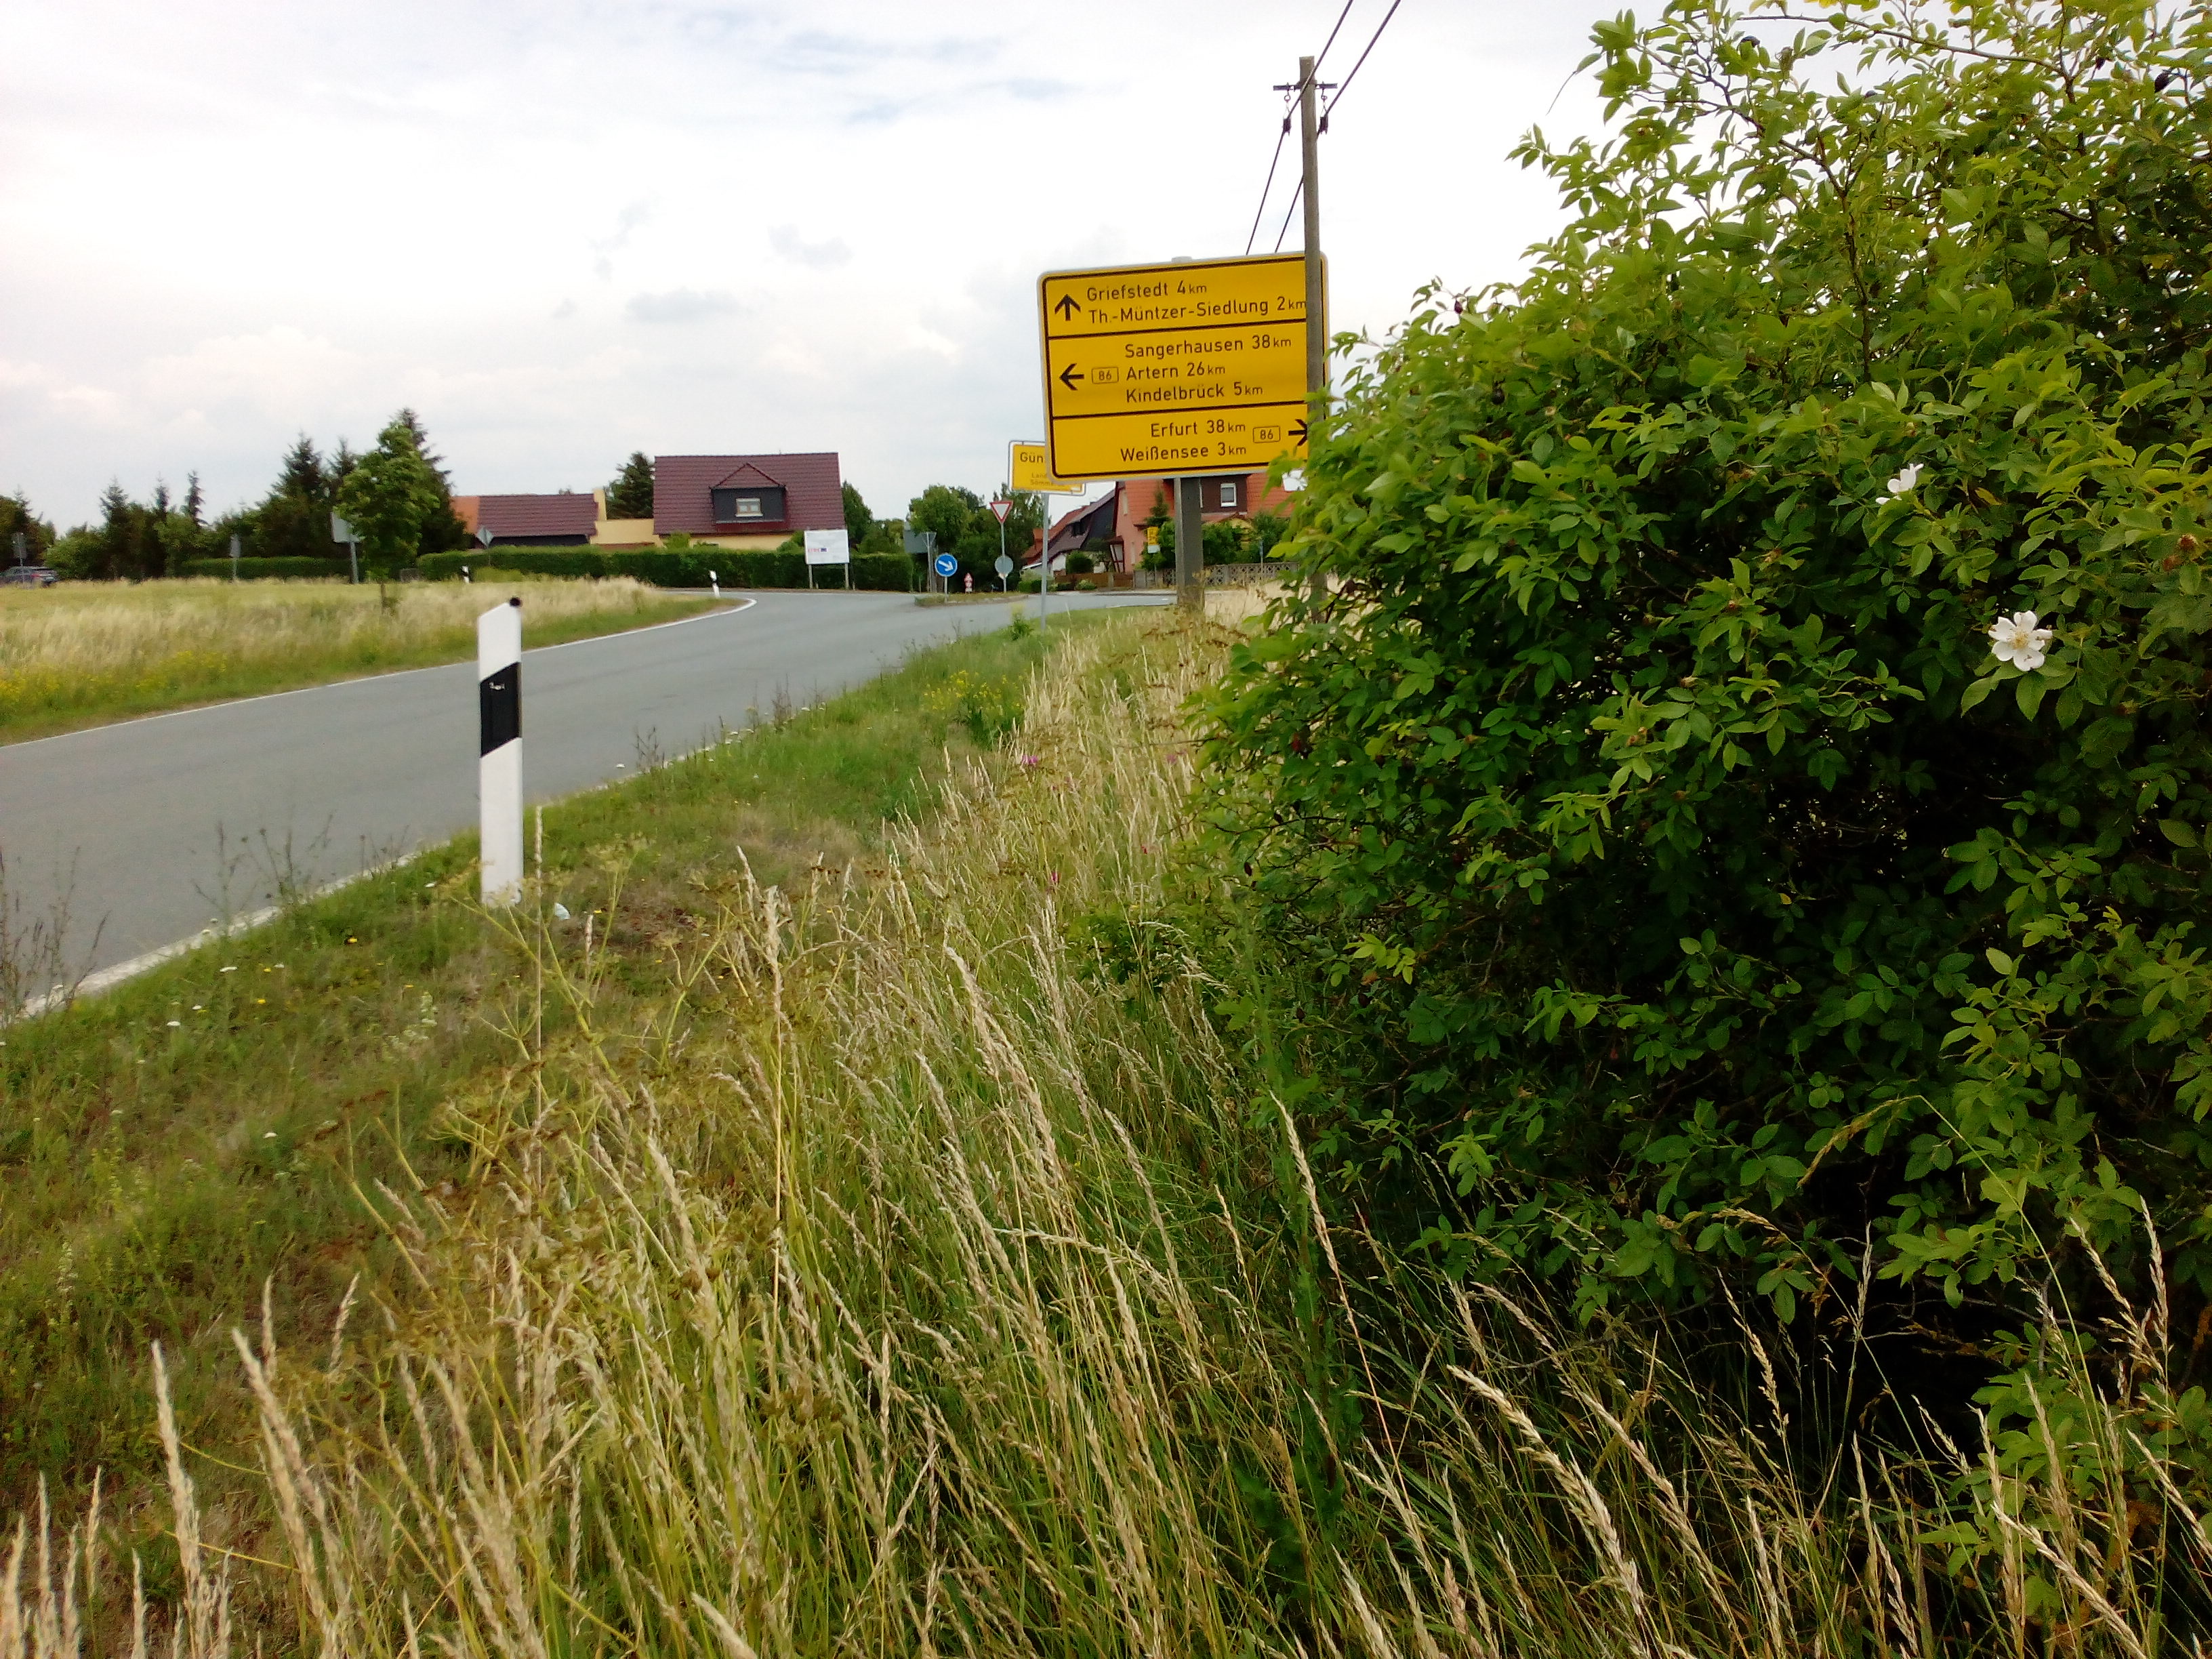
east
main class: Grassland
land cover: Grassland without tree/shrub cover
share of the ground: > 75 %
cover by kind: herbaceous plants 95 %, shrubs 5 %
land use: Agriculture (excluding fallow land and kitchen gardens)
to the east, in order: Grassland without tree/shrub cover; Artificial constructions in urban areas
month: June
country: DE
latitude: 51.2221
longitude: 11.0736
